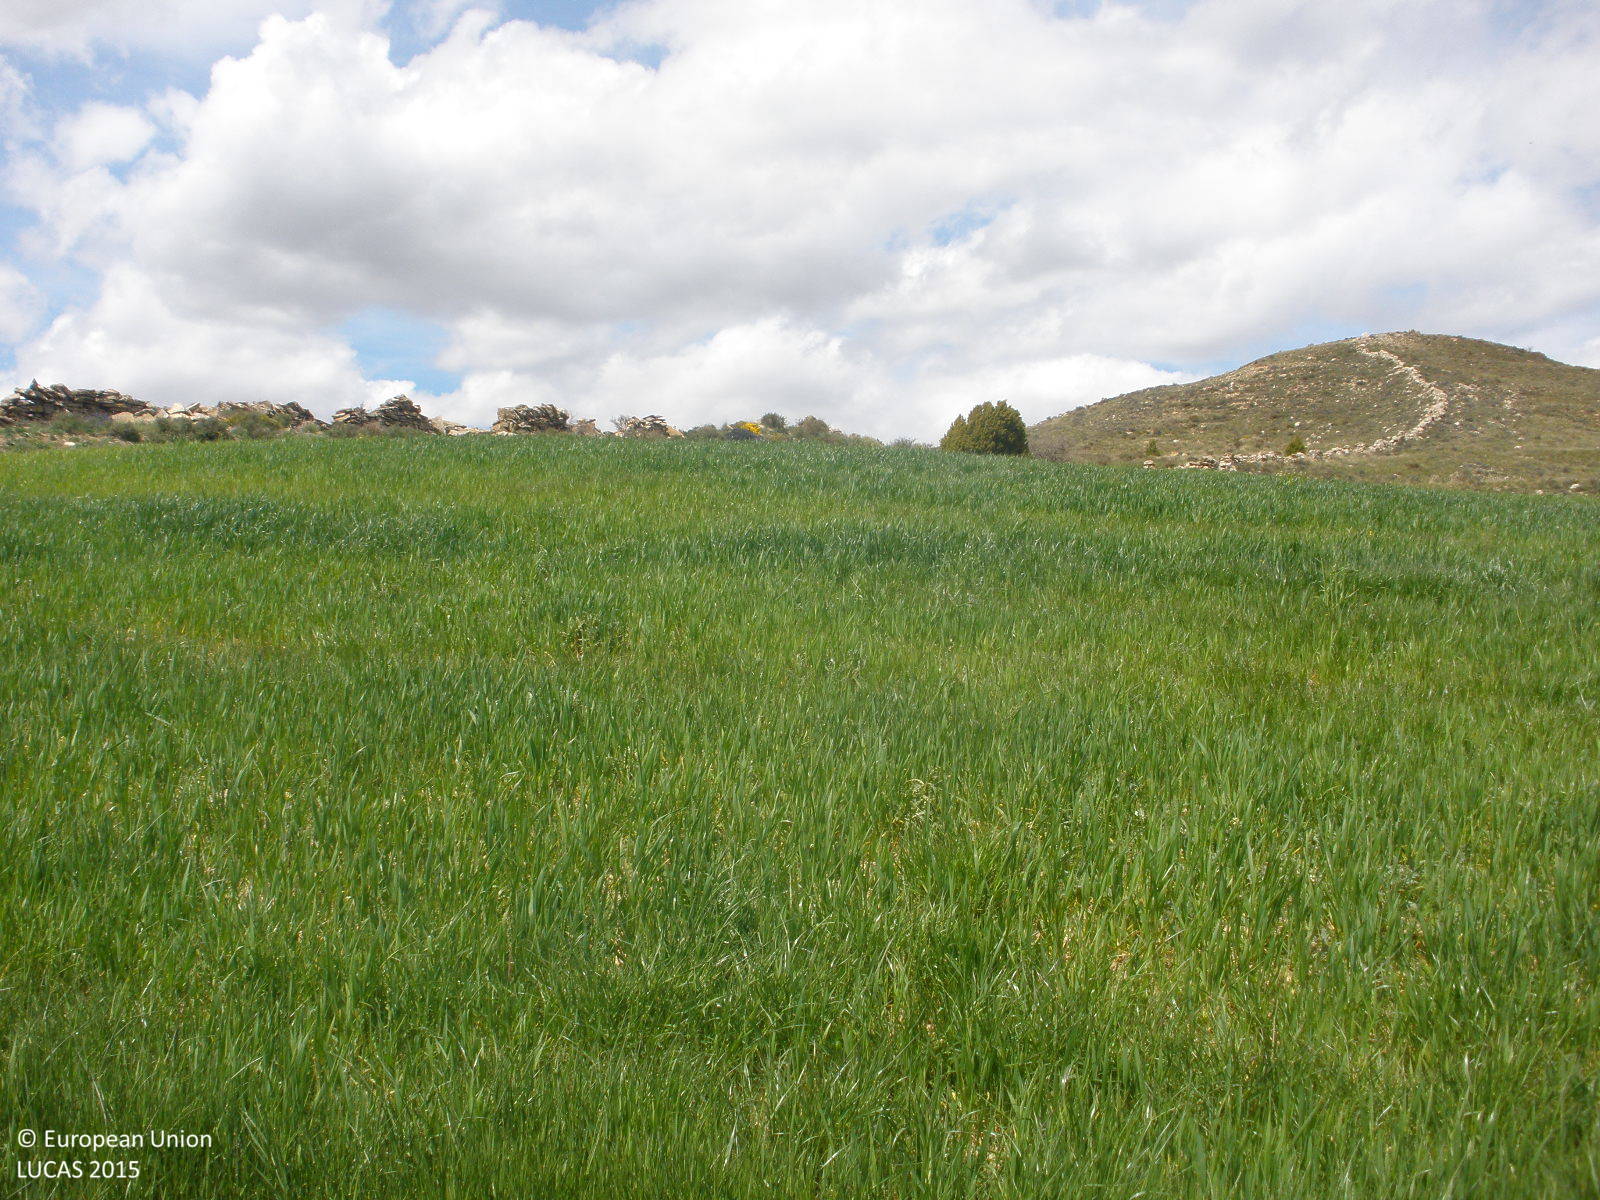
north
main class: Cropland
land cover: Barley
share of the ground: > 75 %
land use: Agriculture (excluding fallow land and kitchen gardens)
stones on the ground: 10 - 25 %
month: April
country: ES
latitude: 40.4510
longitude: -0.8223
